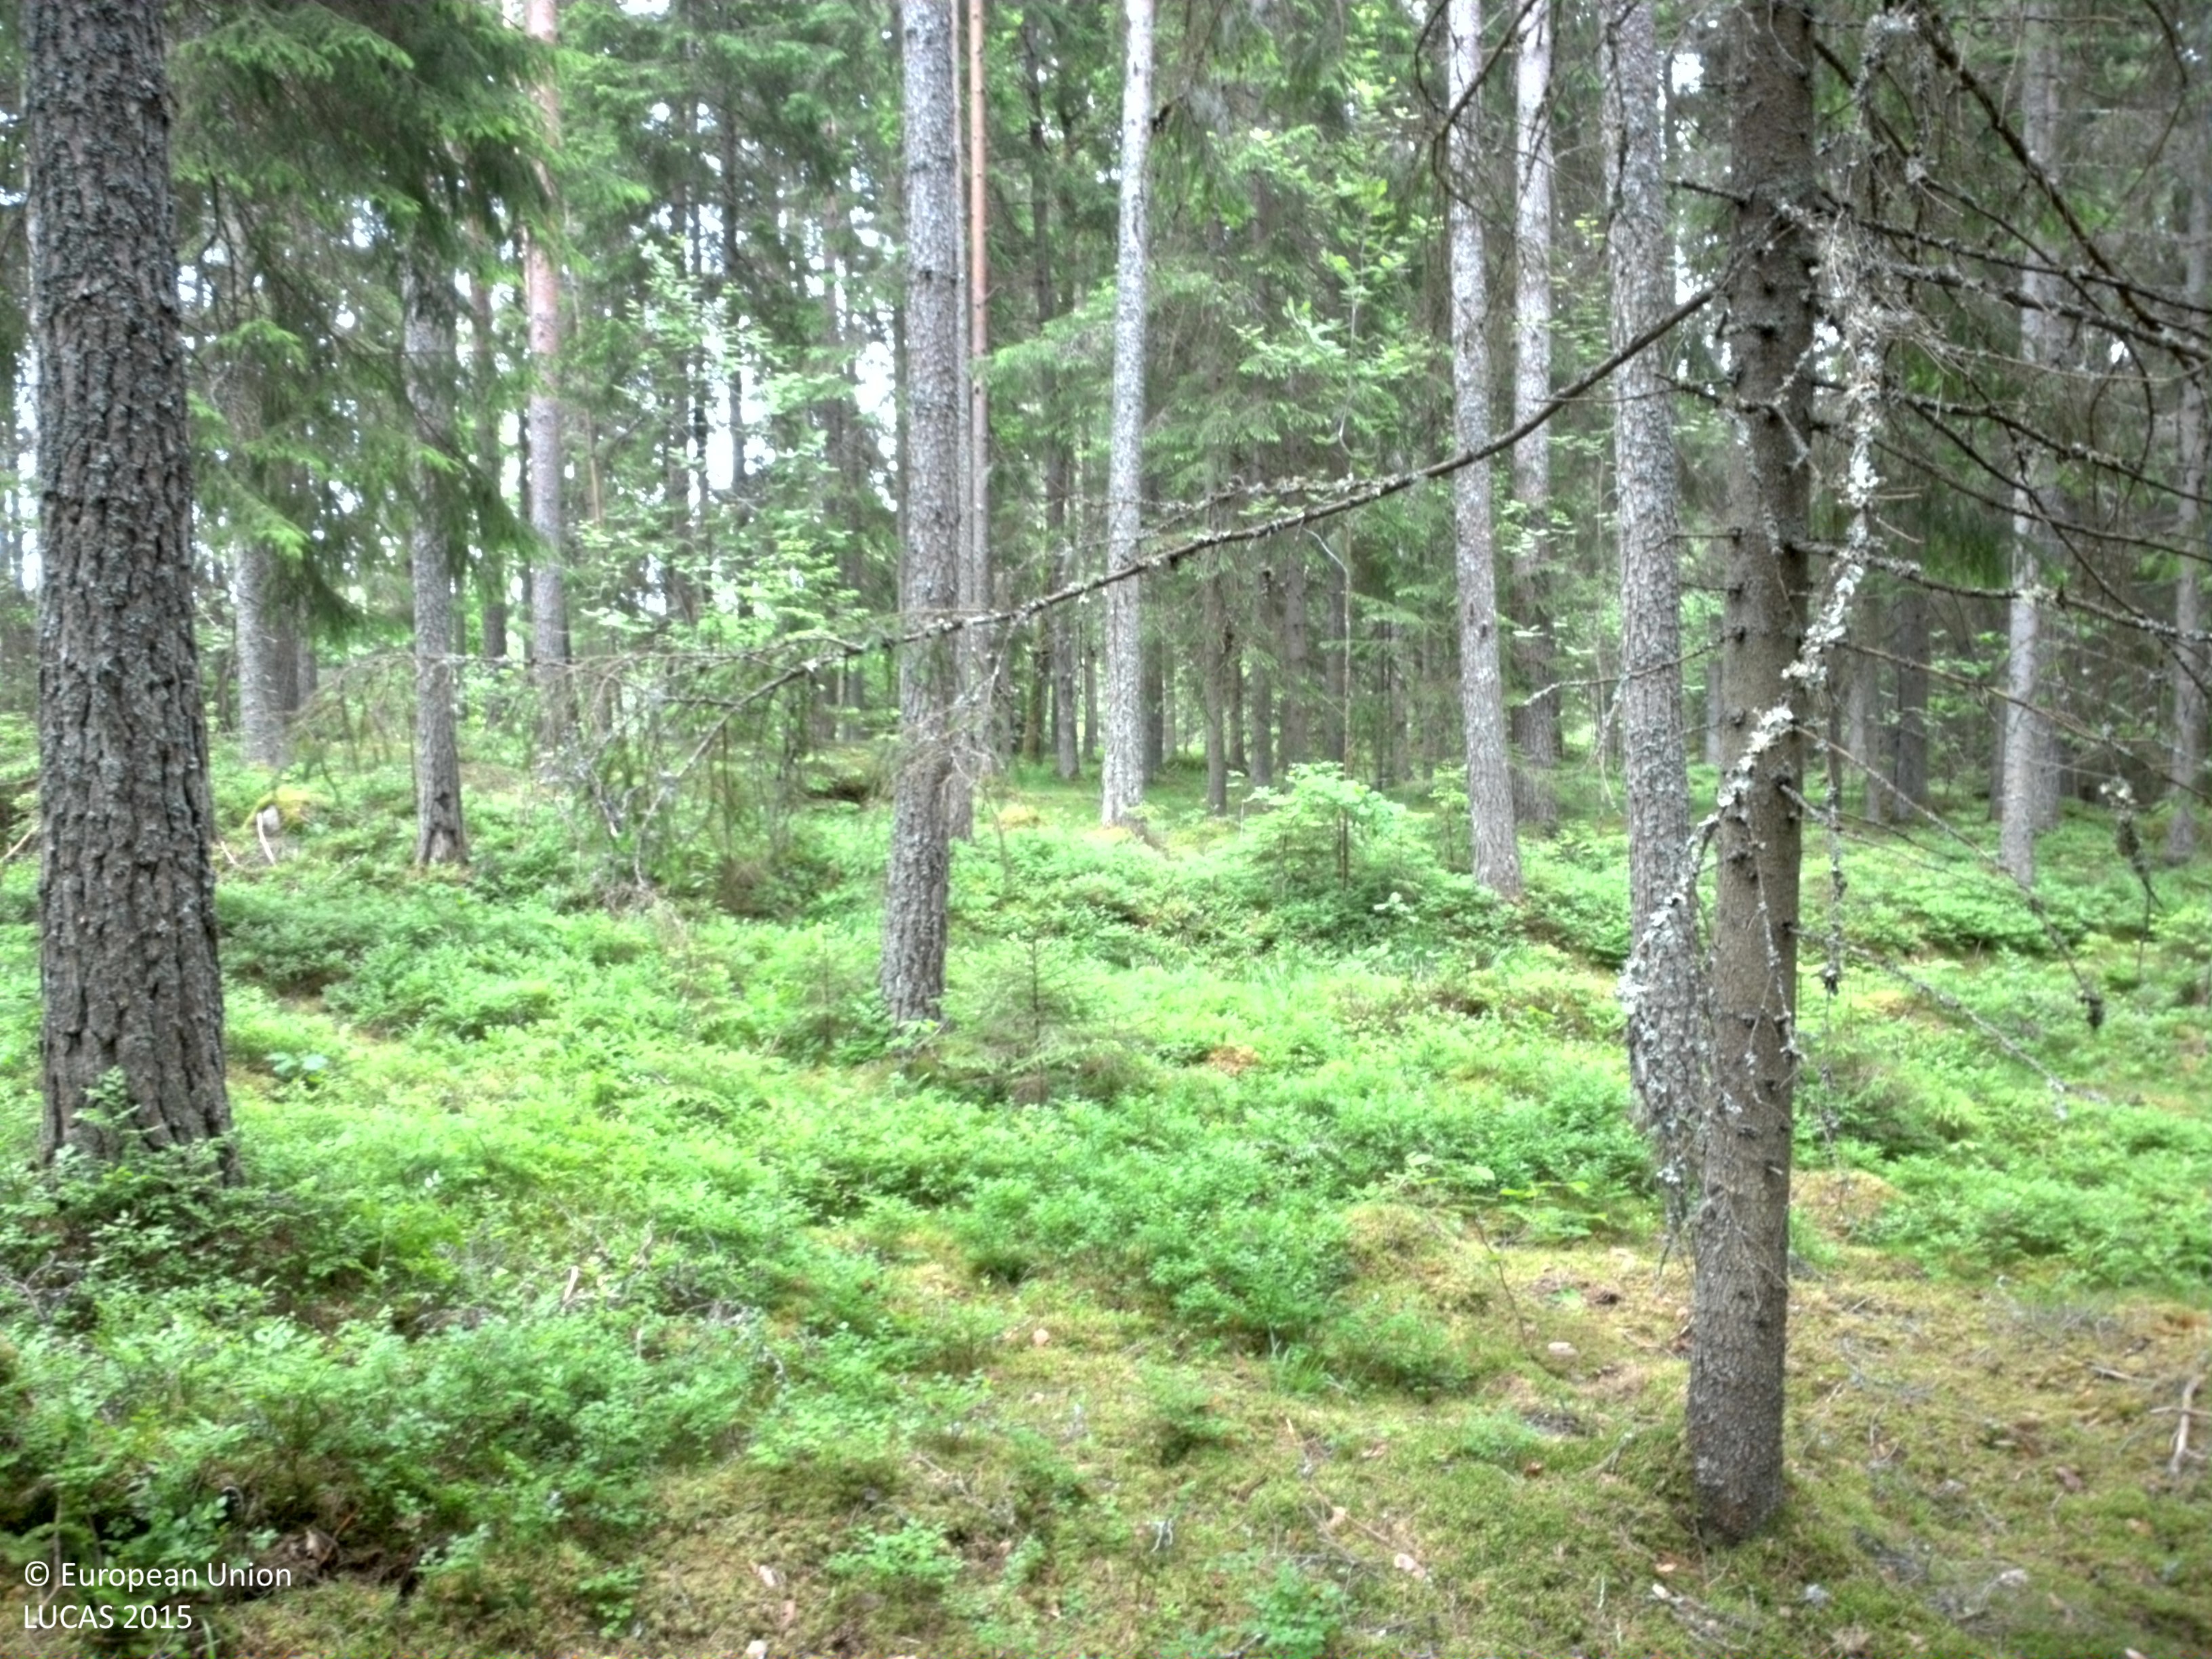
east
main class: Woodland
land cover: Spruce dominated coniferous woodland
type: boreal forest
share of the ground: 25 - 50 %
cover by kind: coniferous forest trees 40 %, herbaceous plants 35 %, lichens and mosses 20 %, broadleaved forest trees 5 %
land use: Forestry
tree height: > 5 m
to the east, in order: Spruce dominated coniferous woodland; Ditches and canals; Electric lines; Paved roads, cycling and walking lanes; Ditches and canals; Spruce dominated coniferous woodland; Spruce dominated mixed woodland; Spruce dominated coniferous woodland
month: June
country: SE
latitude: 58.7367
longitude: 15.5390
